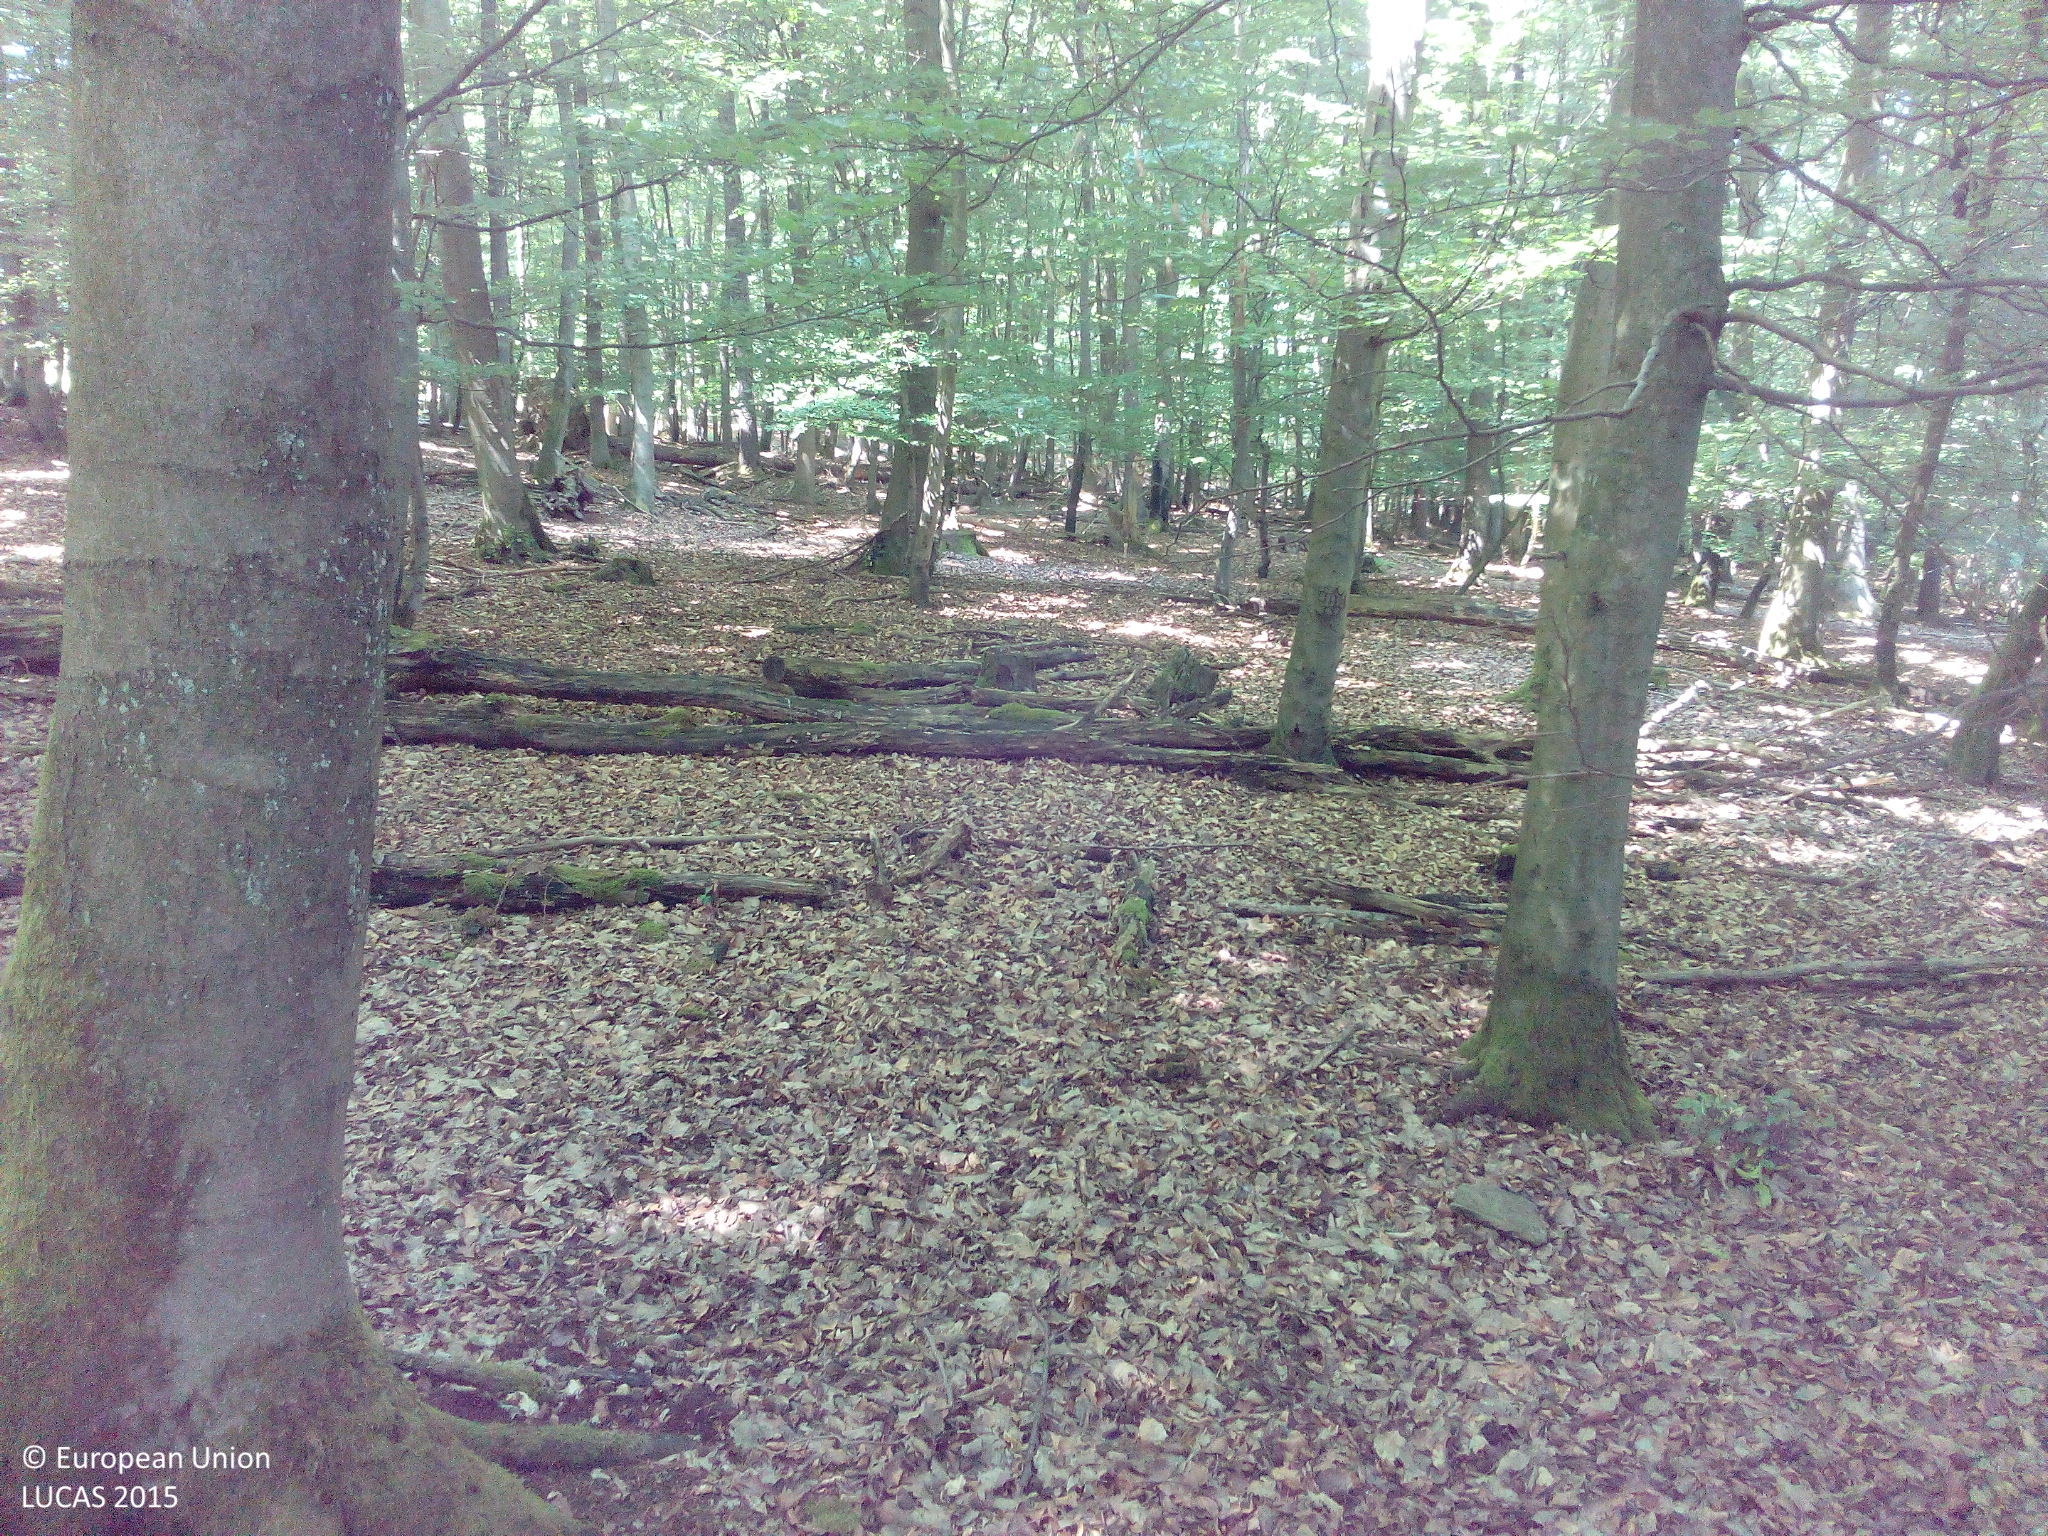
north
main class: Woodland
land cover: Broadleaved woodland
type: mesophytic deciduous forest
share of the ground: > 75 %
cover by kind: broadleaved forest trees 90 %, unconsolidated bare surface 10 %
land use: Forestry
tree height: > 5 m
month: June
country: DE
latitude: 50.1851
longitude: 8.0257
